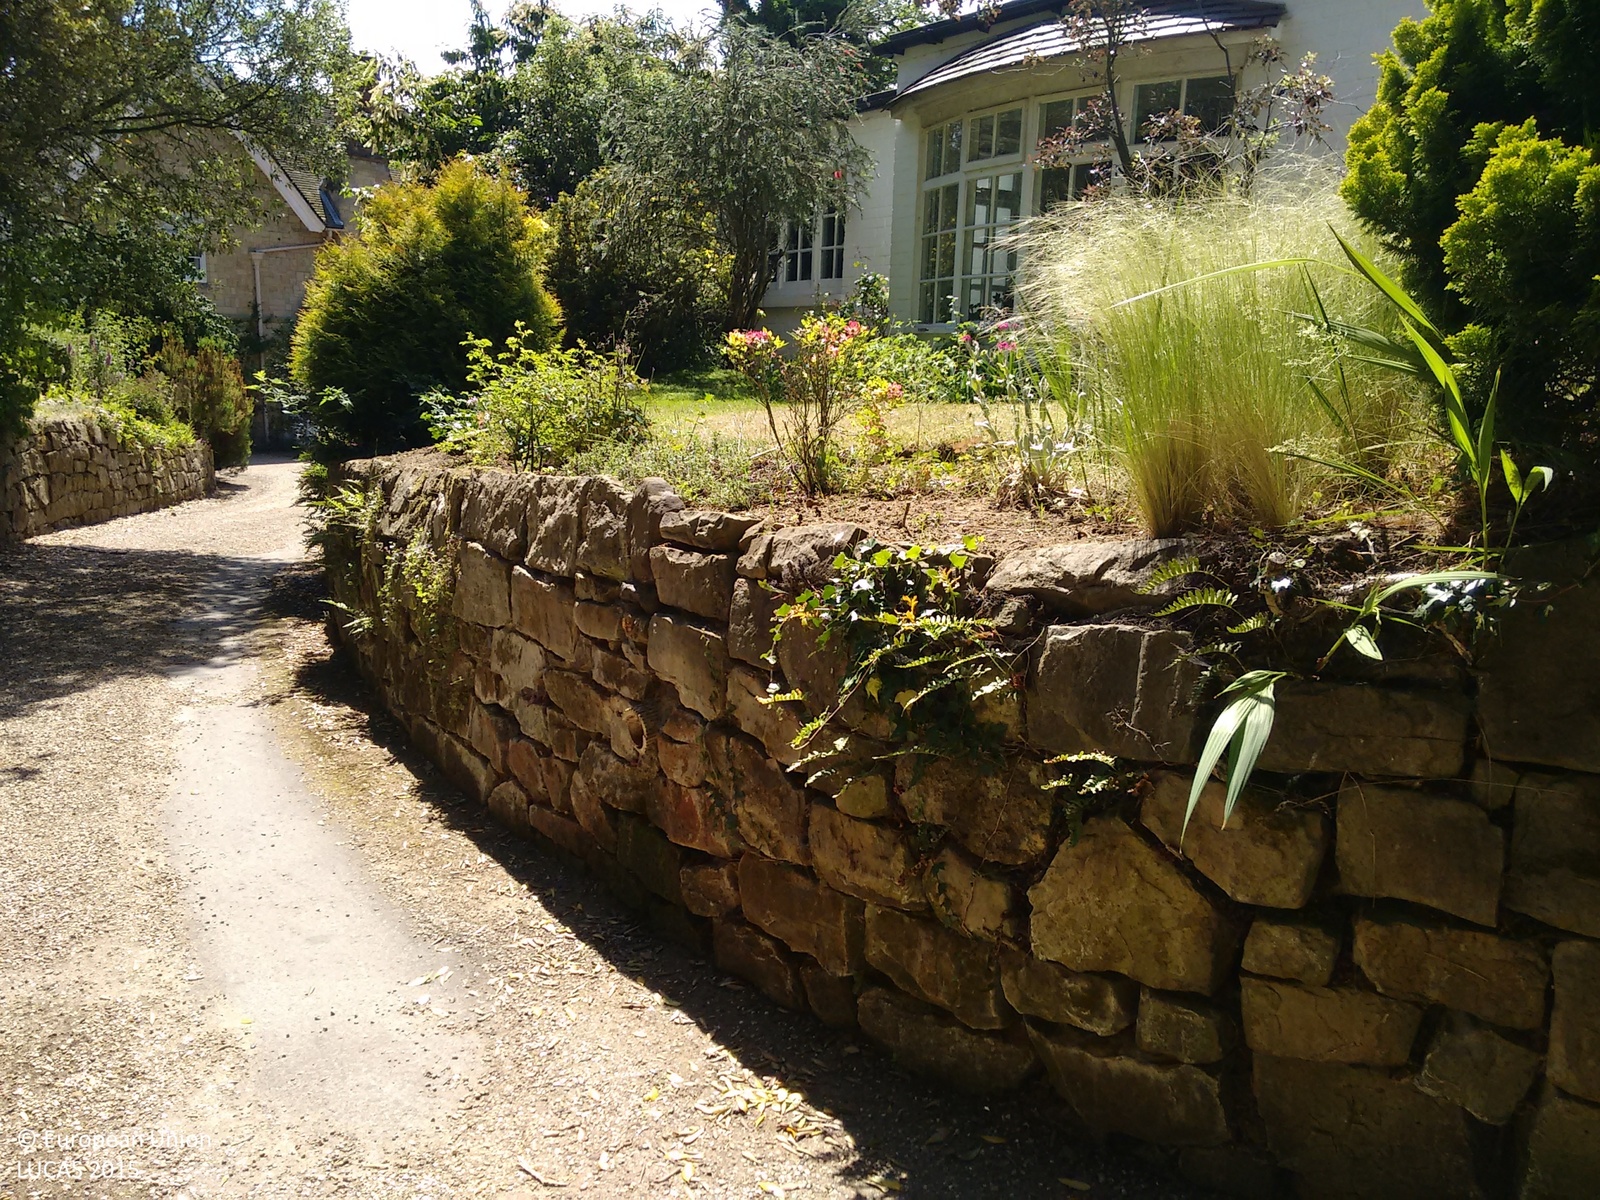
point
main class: Grassland
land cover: Grassland with sparse tree/shrub cover
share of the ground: > 75 %
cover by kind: herbaceous plants 85 %, shrubs 10 %, broadleaved forest trees 5 %
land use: Residential
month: June
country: GB
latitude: 51.2286
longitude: -0.2170
